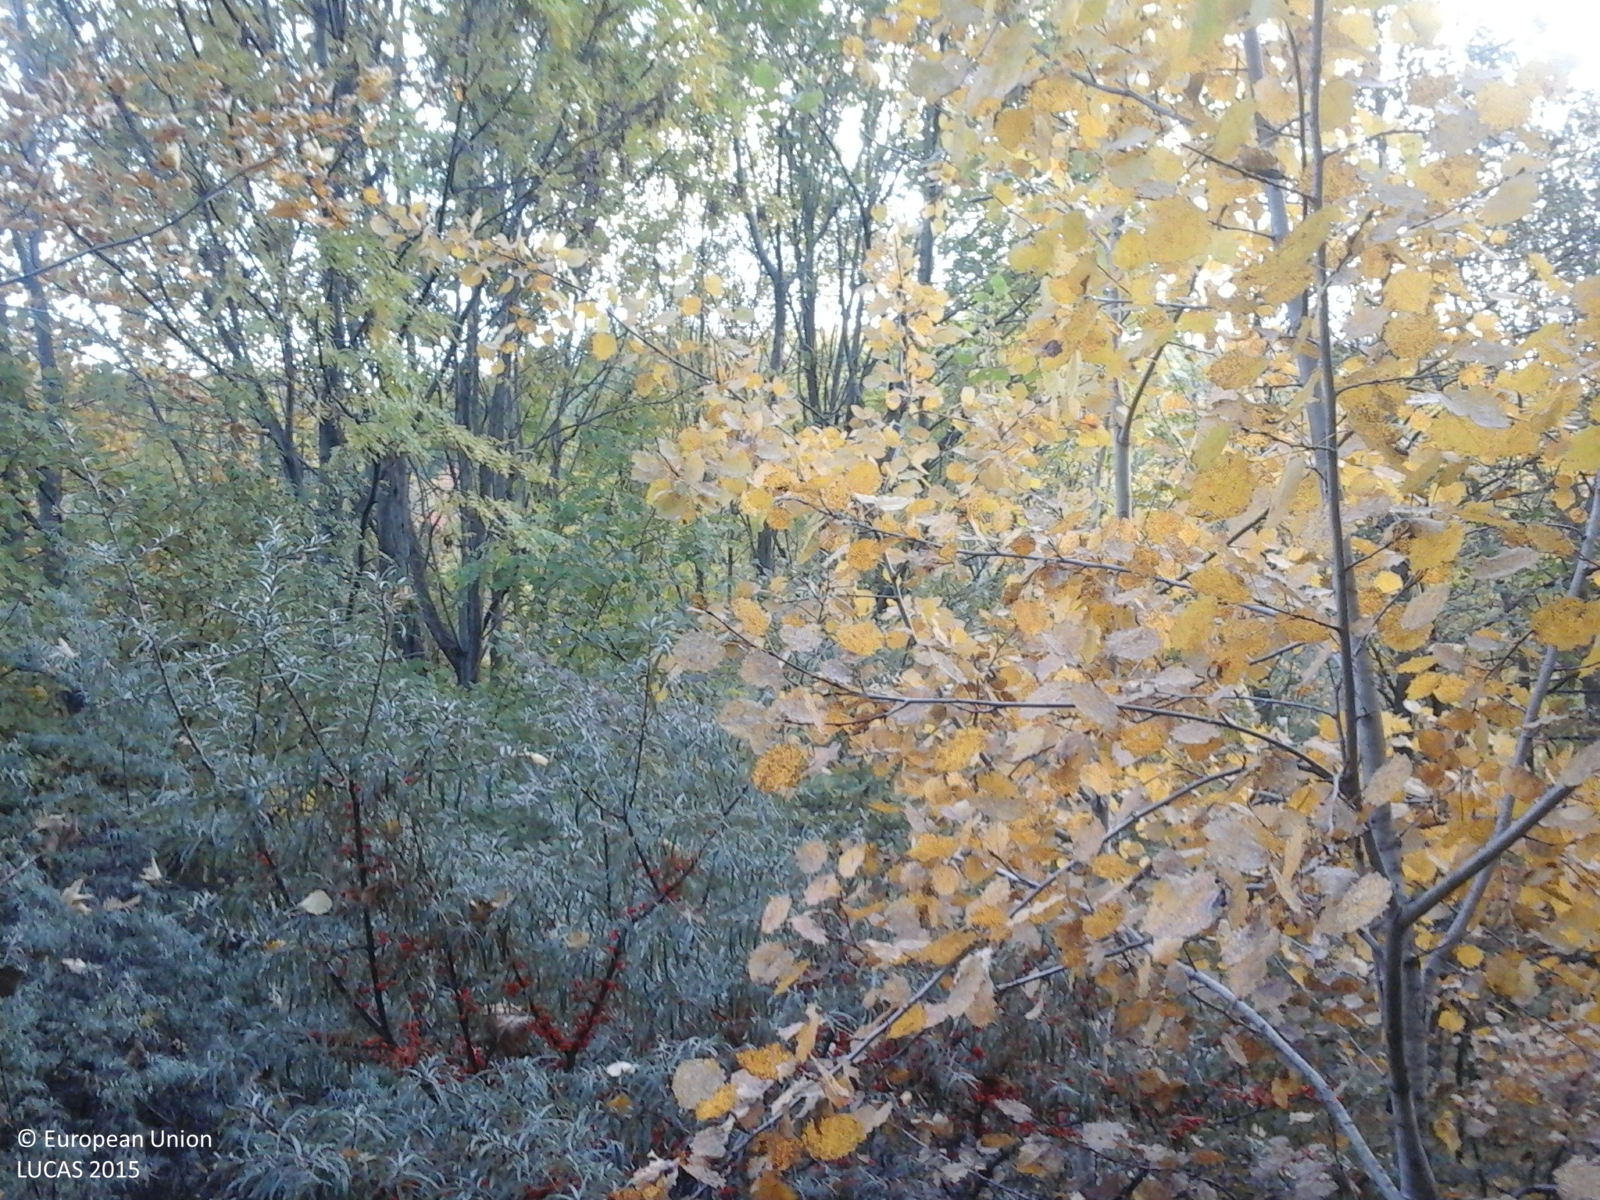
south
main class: Woodland
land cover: Broadleaved woodland
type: non-riverine alder, birch or aspen forest
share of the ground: > 75 %
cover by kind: broadleaved forest trees 100 %
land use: Forestry
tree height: > 5 m
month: October
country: RO
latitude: 45.3641
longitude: 26.4258
